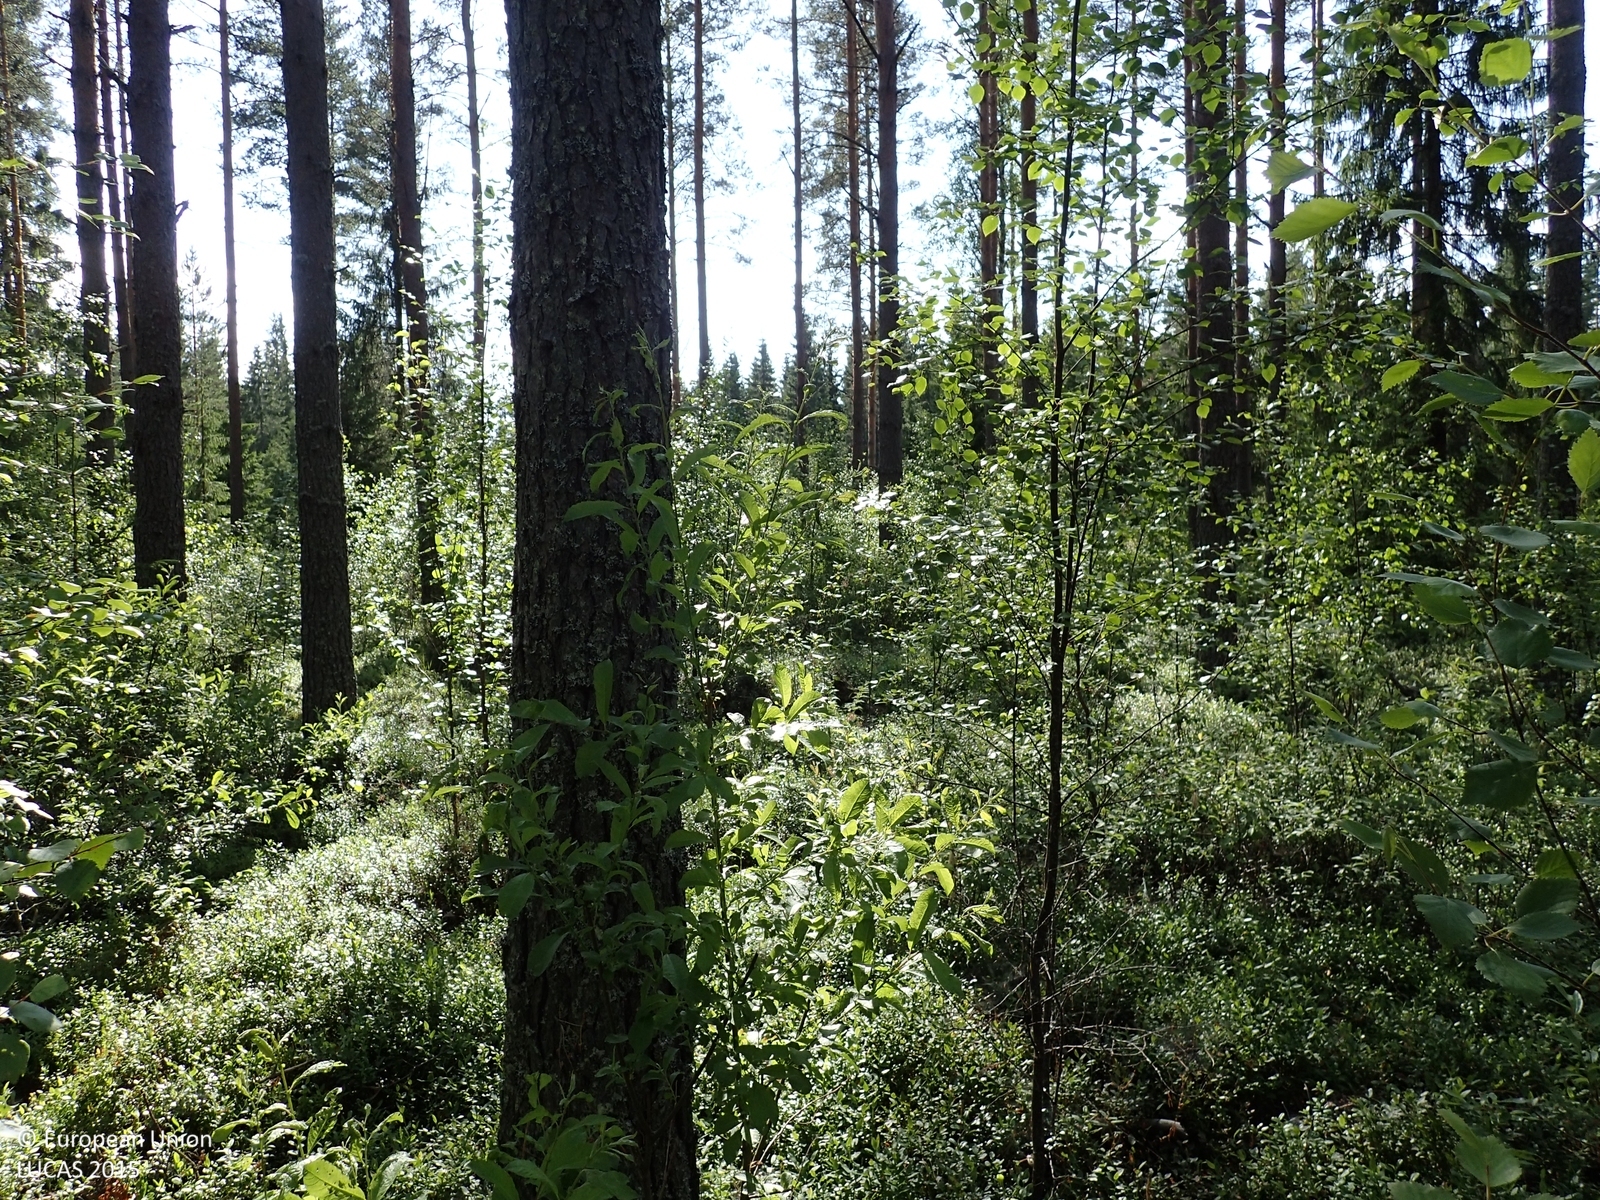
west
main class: Woodland
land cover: Pine dominated mixed woodland
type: boreal forest
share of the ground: 25 - 50 %
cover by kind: shrubs 60 %, coniferous forest trees 30 %, broadleaved forest trees 10 %
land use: Forestry
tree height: > 5 m
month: July
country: FI
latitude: 62.8281
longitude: 23.2744
